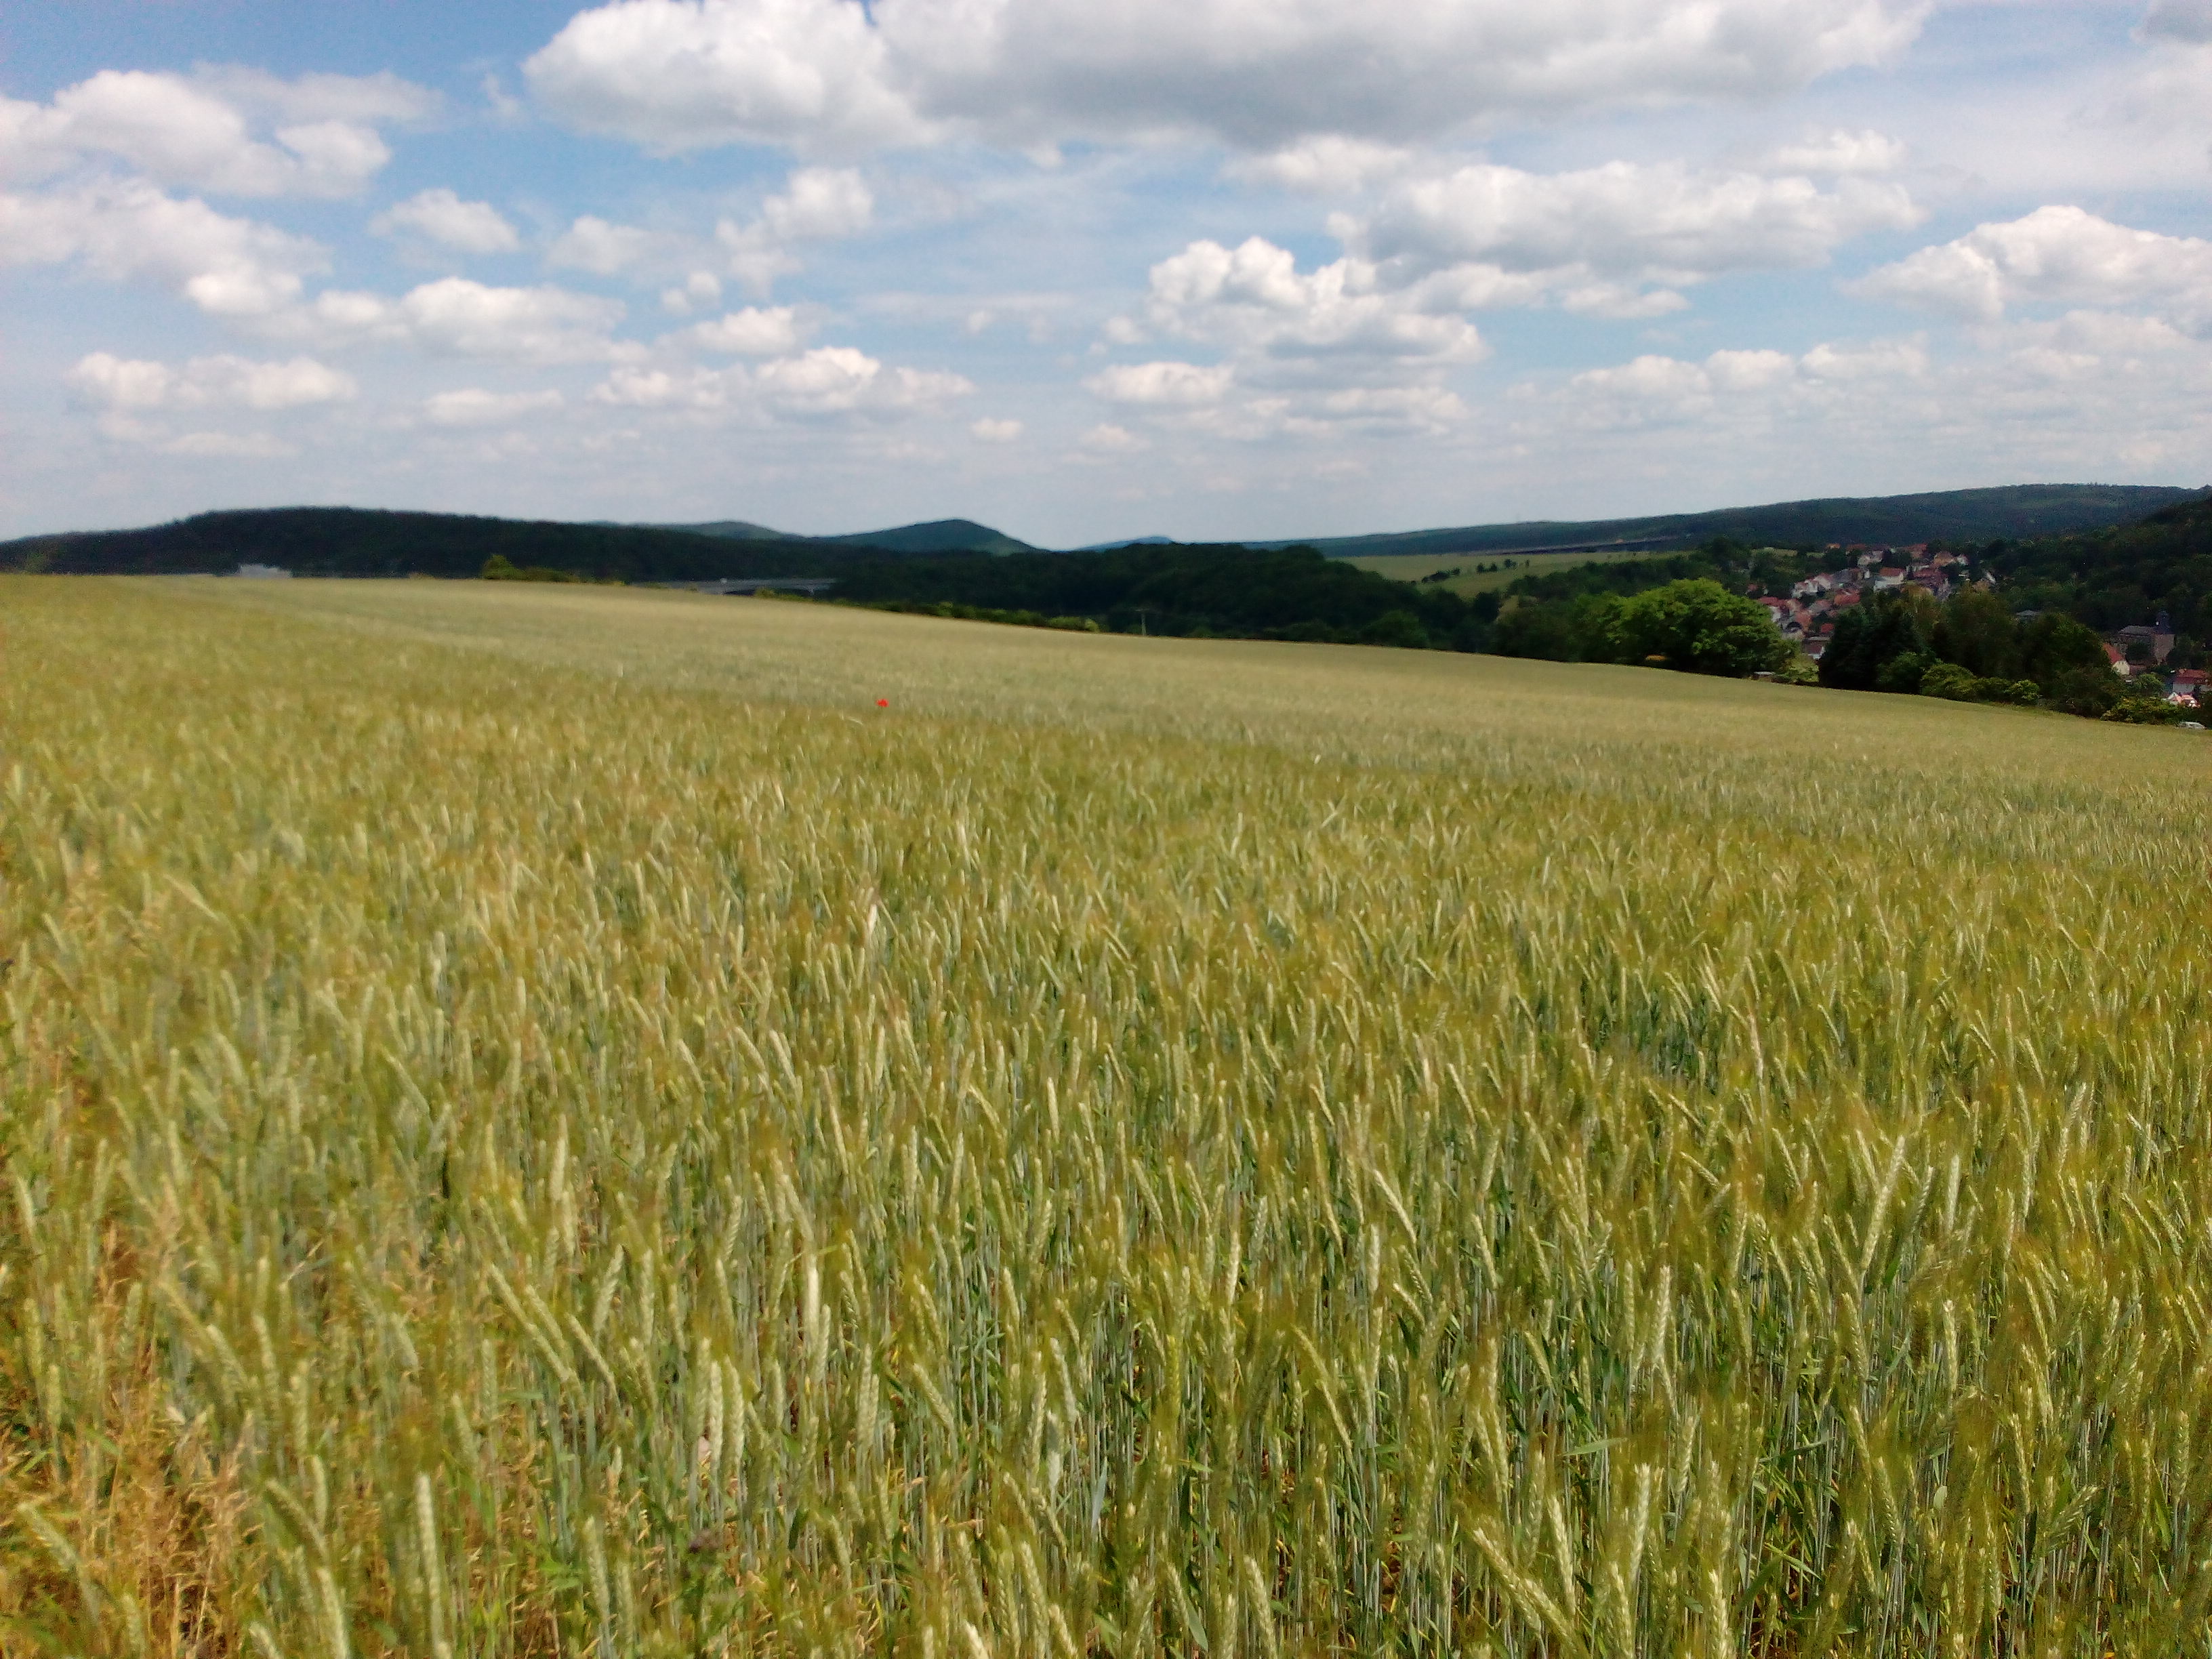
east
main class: Cropland
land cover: Triticale
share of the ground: > 75 %
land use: Agriculture (excluding fallow land and kitchen gardens)
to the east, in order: Triticale
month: June
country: DE
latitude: 50.7206
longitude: 10.8355
